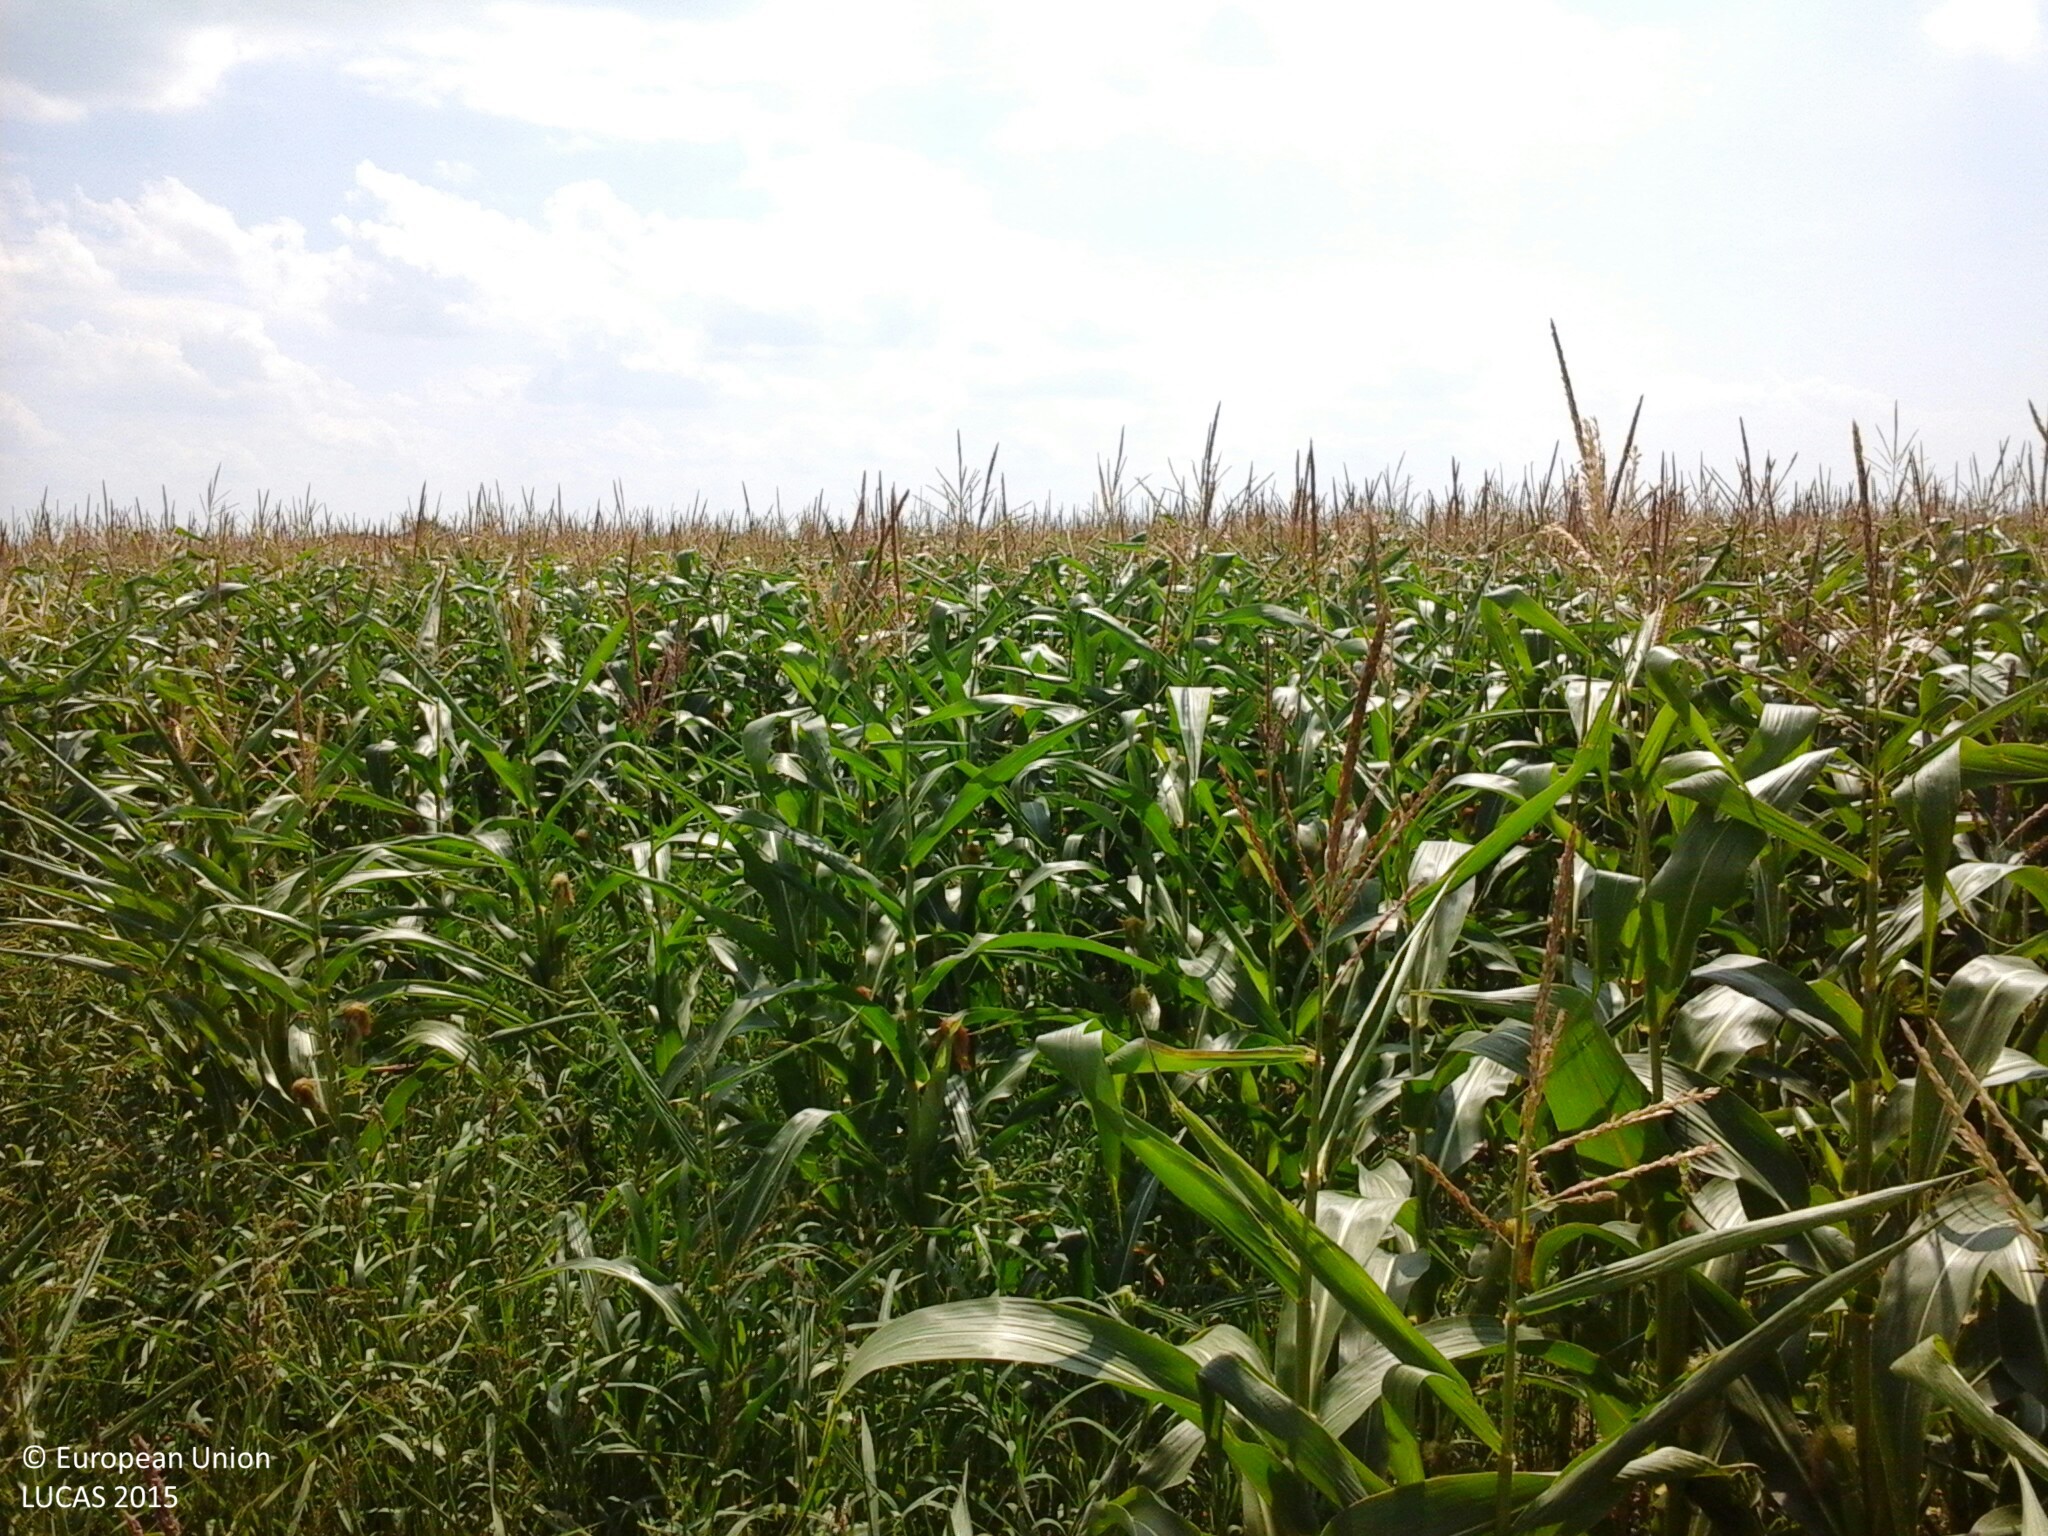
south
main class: Cropland
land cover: Maize
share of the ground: > 75 %
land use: Agriculture (excluding fallow land and kitchen gardens)
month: August
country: HU
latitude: 47.0545
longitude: 18.1326
